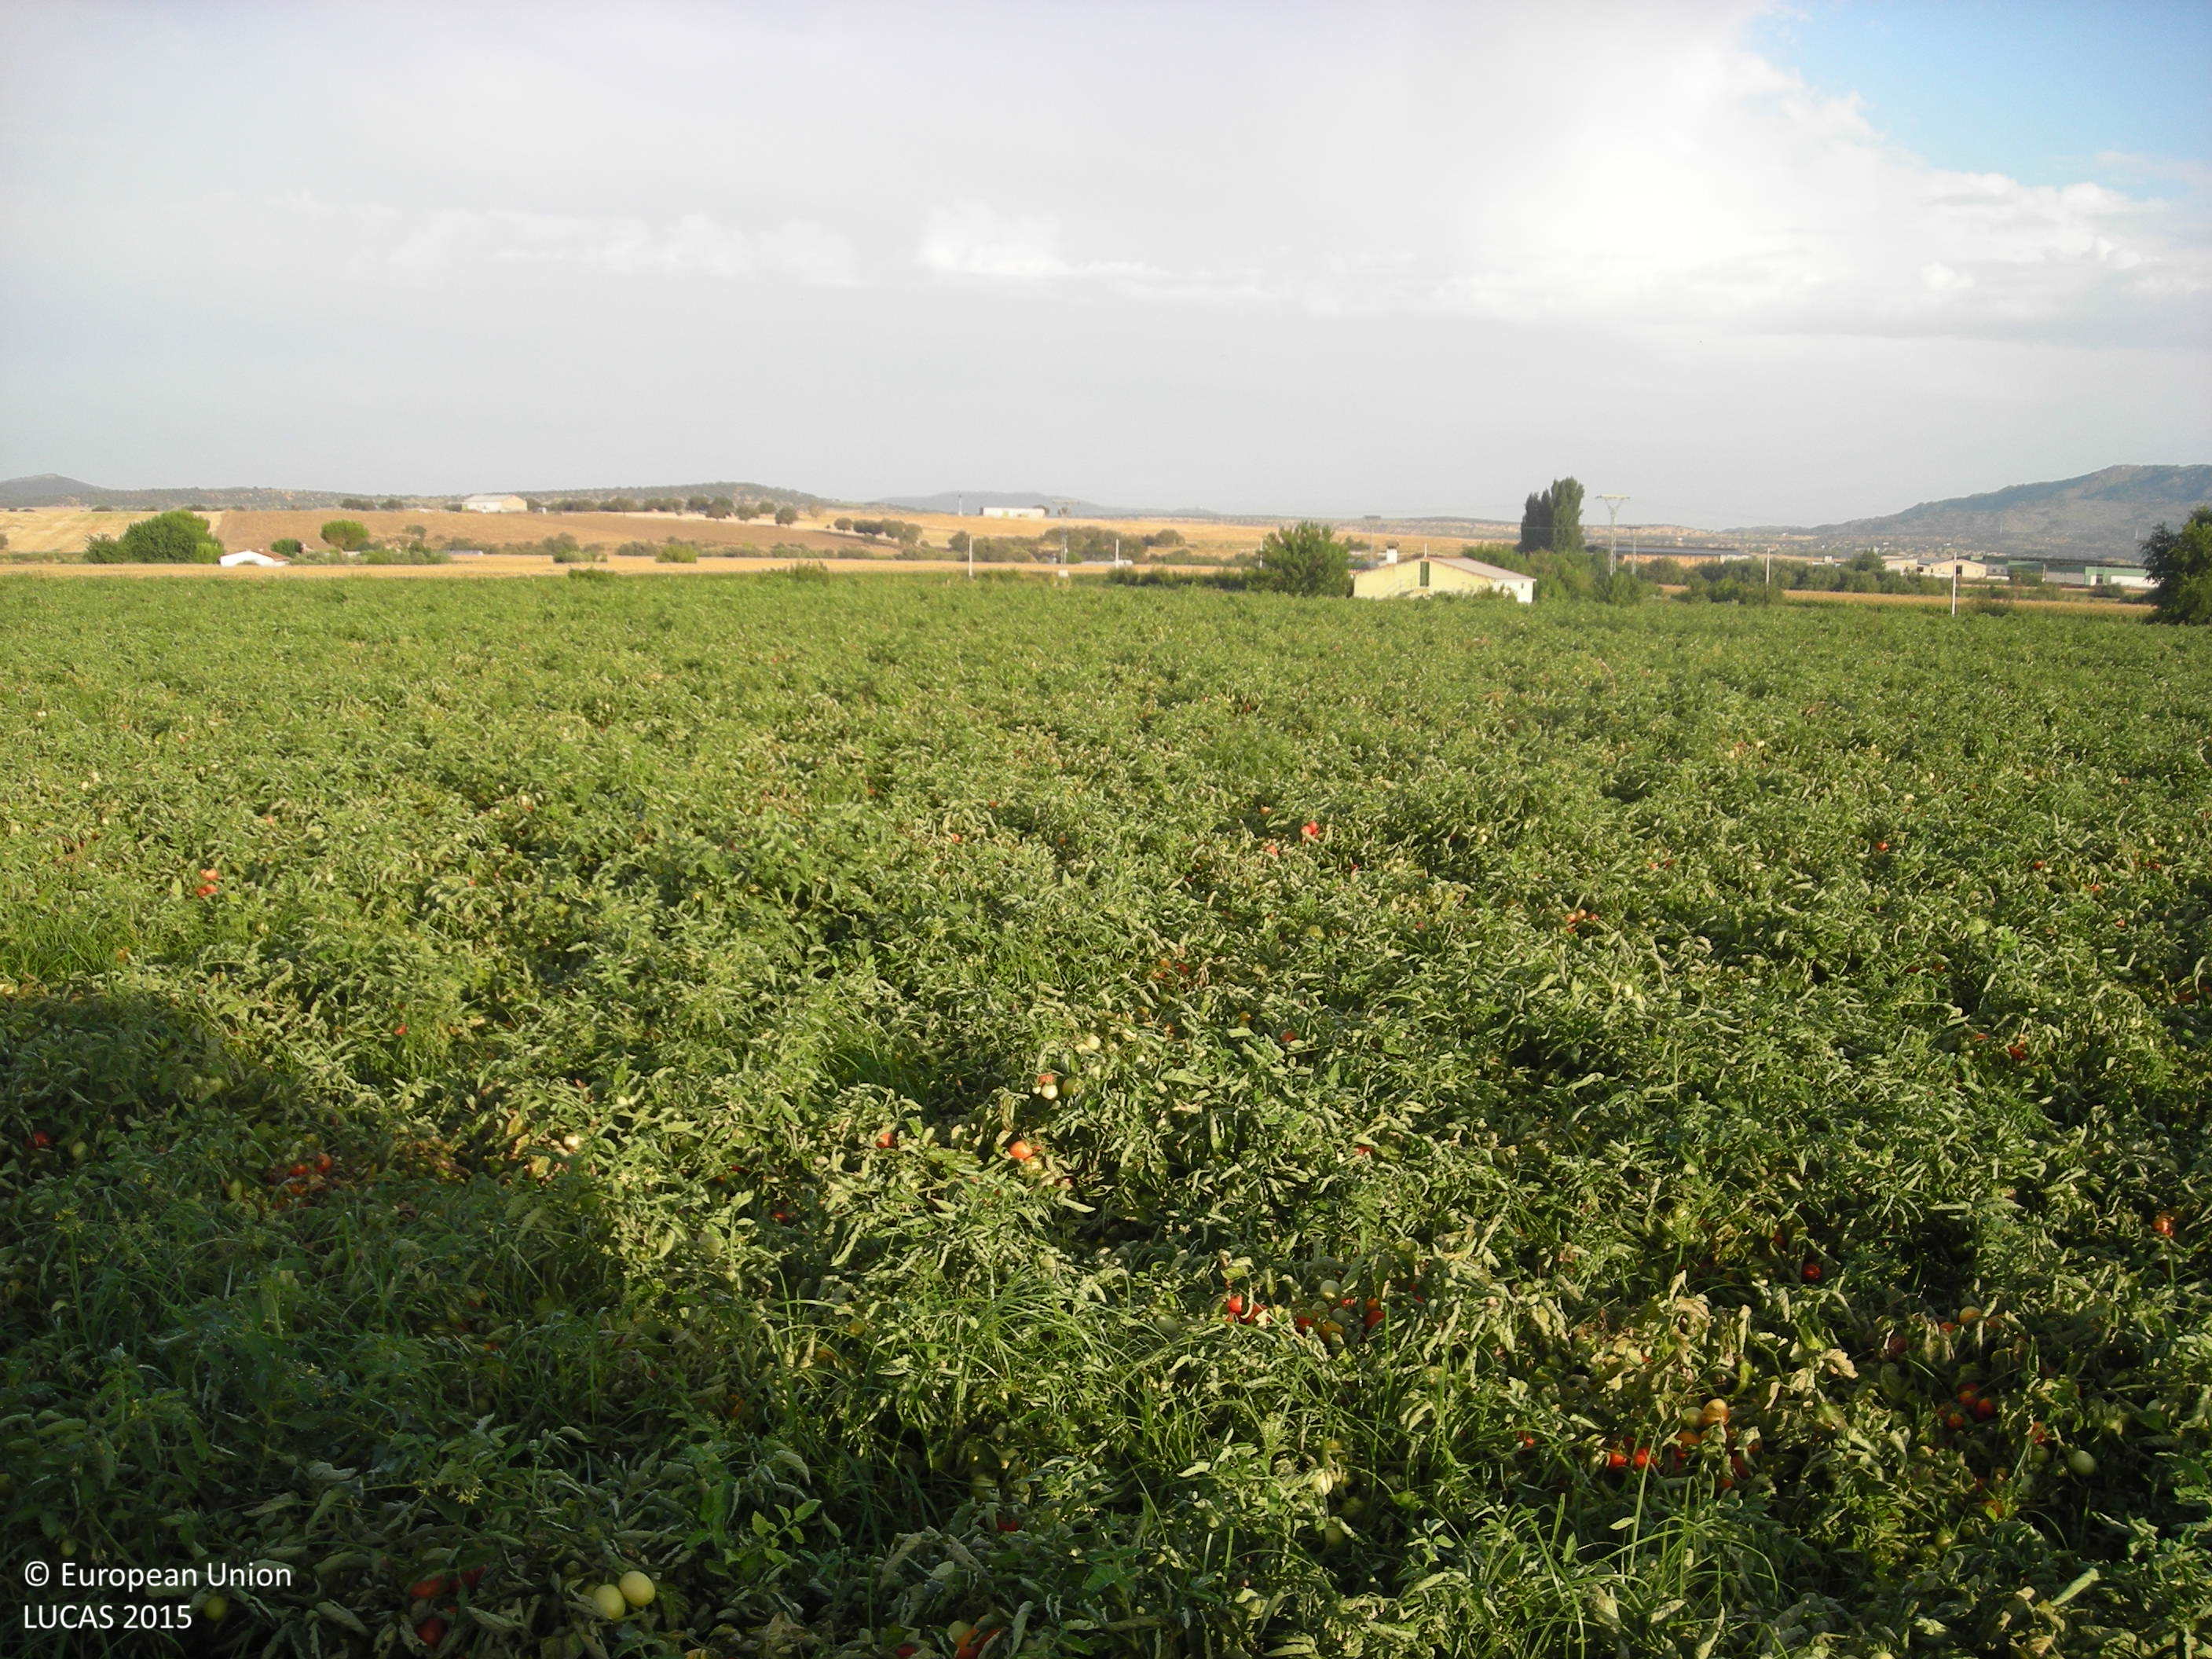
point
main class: Cropland
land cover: Tomatoes
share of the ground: > 75 %
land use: Agriculture (excluding fallow land and kitchen gardens)
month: July
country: ES
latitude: 39.1276
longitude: -6.0065
